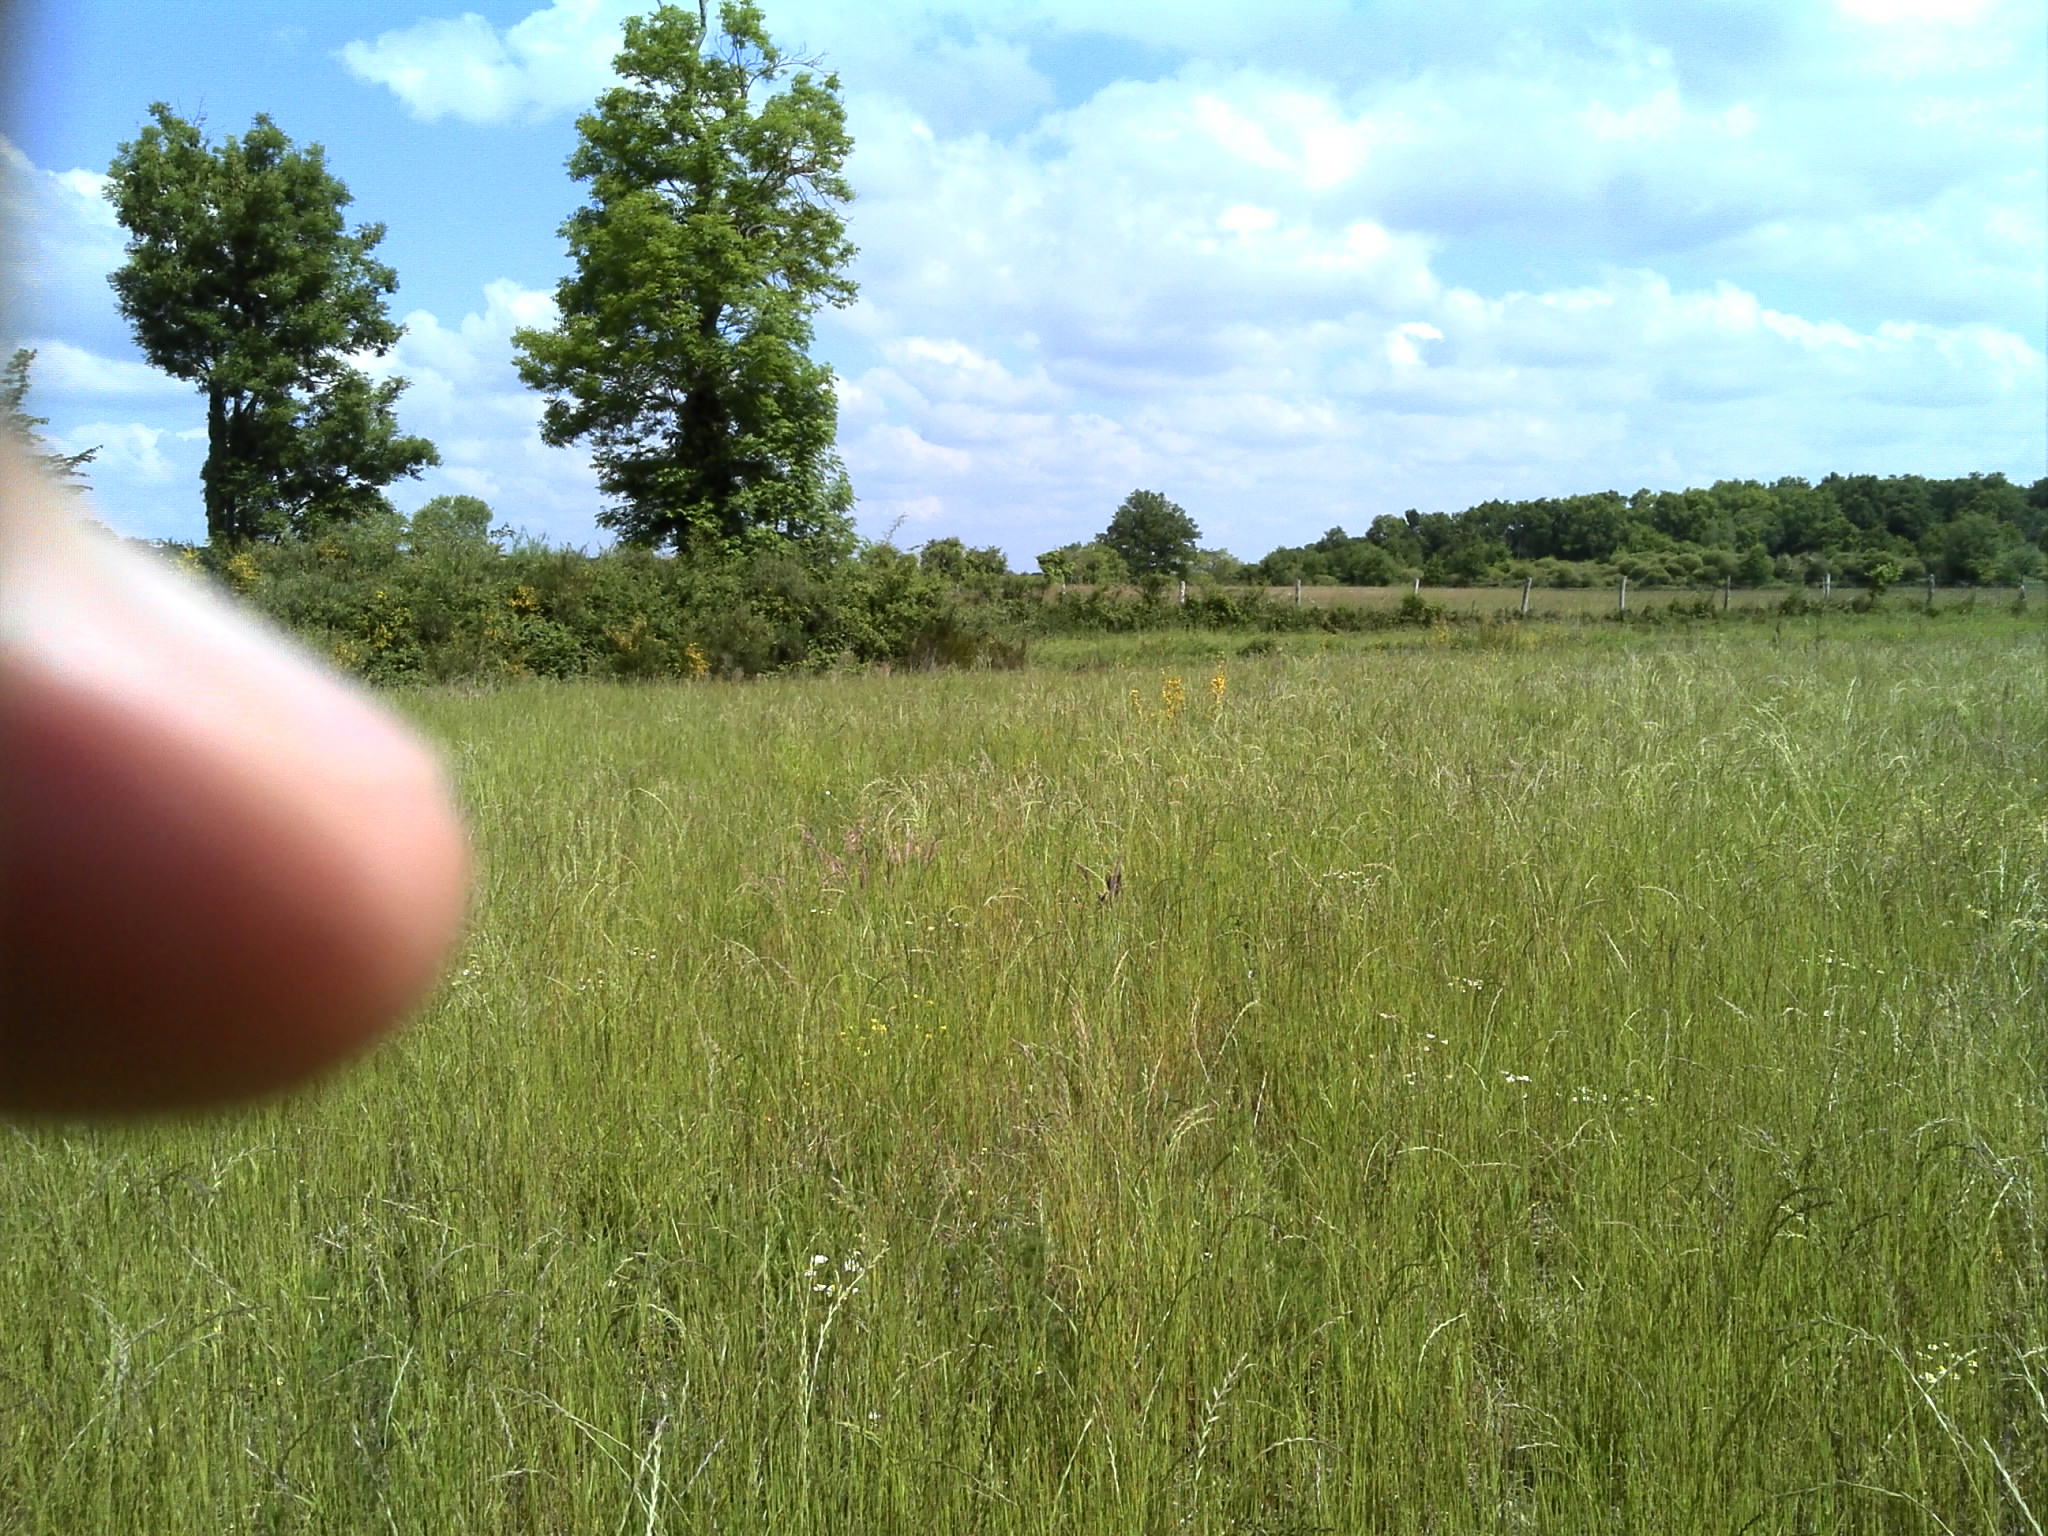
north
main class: Cropland
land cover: Temporary grasslands
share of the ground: > 75 %
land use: Agriculture (excluding fallow land and kitchen gardens)
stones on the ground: < 10 %
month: May
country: FR
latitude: 46.6709
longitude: 1.5848
